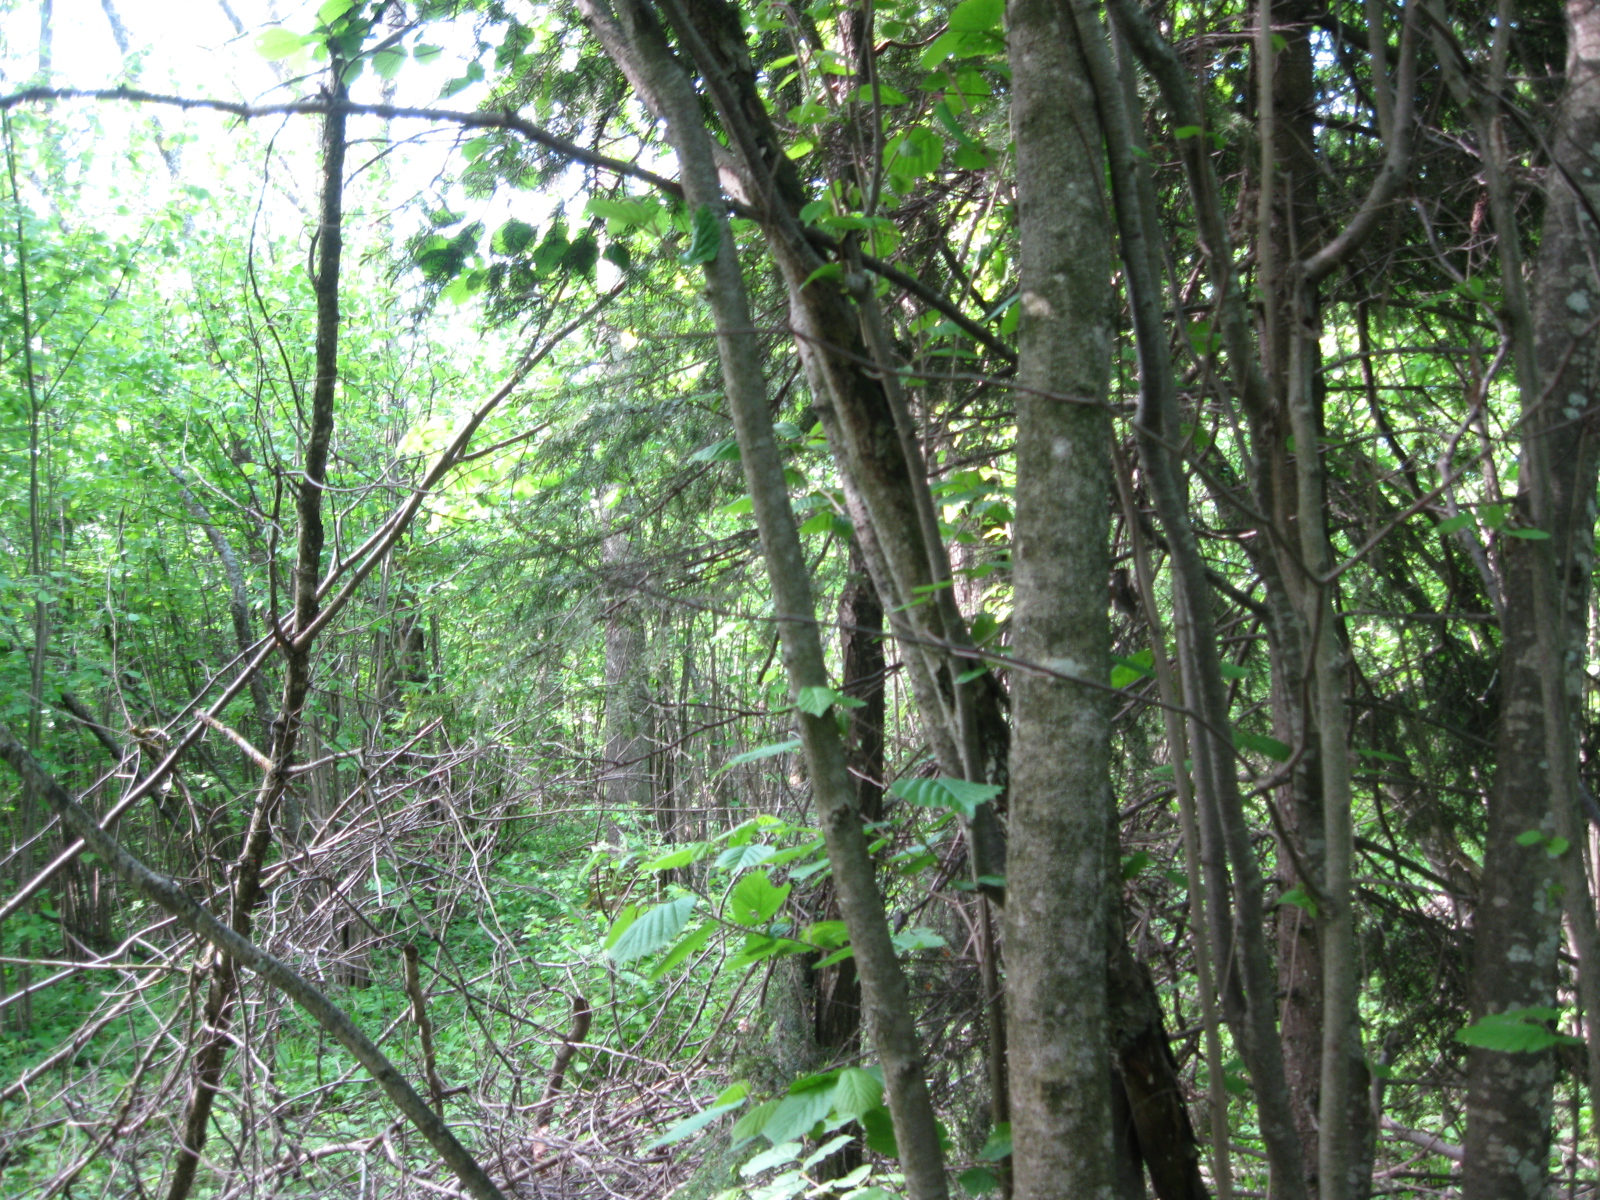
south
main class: Woodland
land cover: Broadleaved woodland
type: non-riverine alder, birch or aspen forest
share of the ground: > 75 %
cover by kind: broadleaved forest trees 90 %, coniferous forest trees 5 %, herbaceous plants 5 %
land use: Forestry
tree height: > 5 m
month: May
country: LT
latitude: 55.9905
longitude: 23.9202
